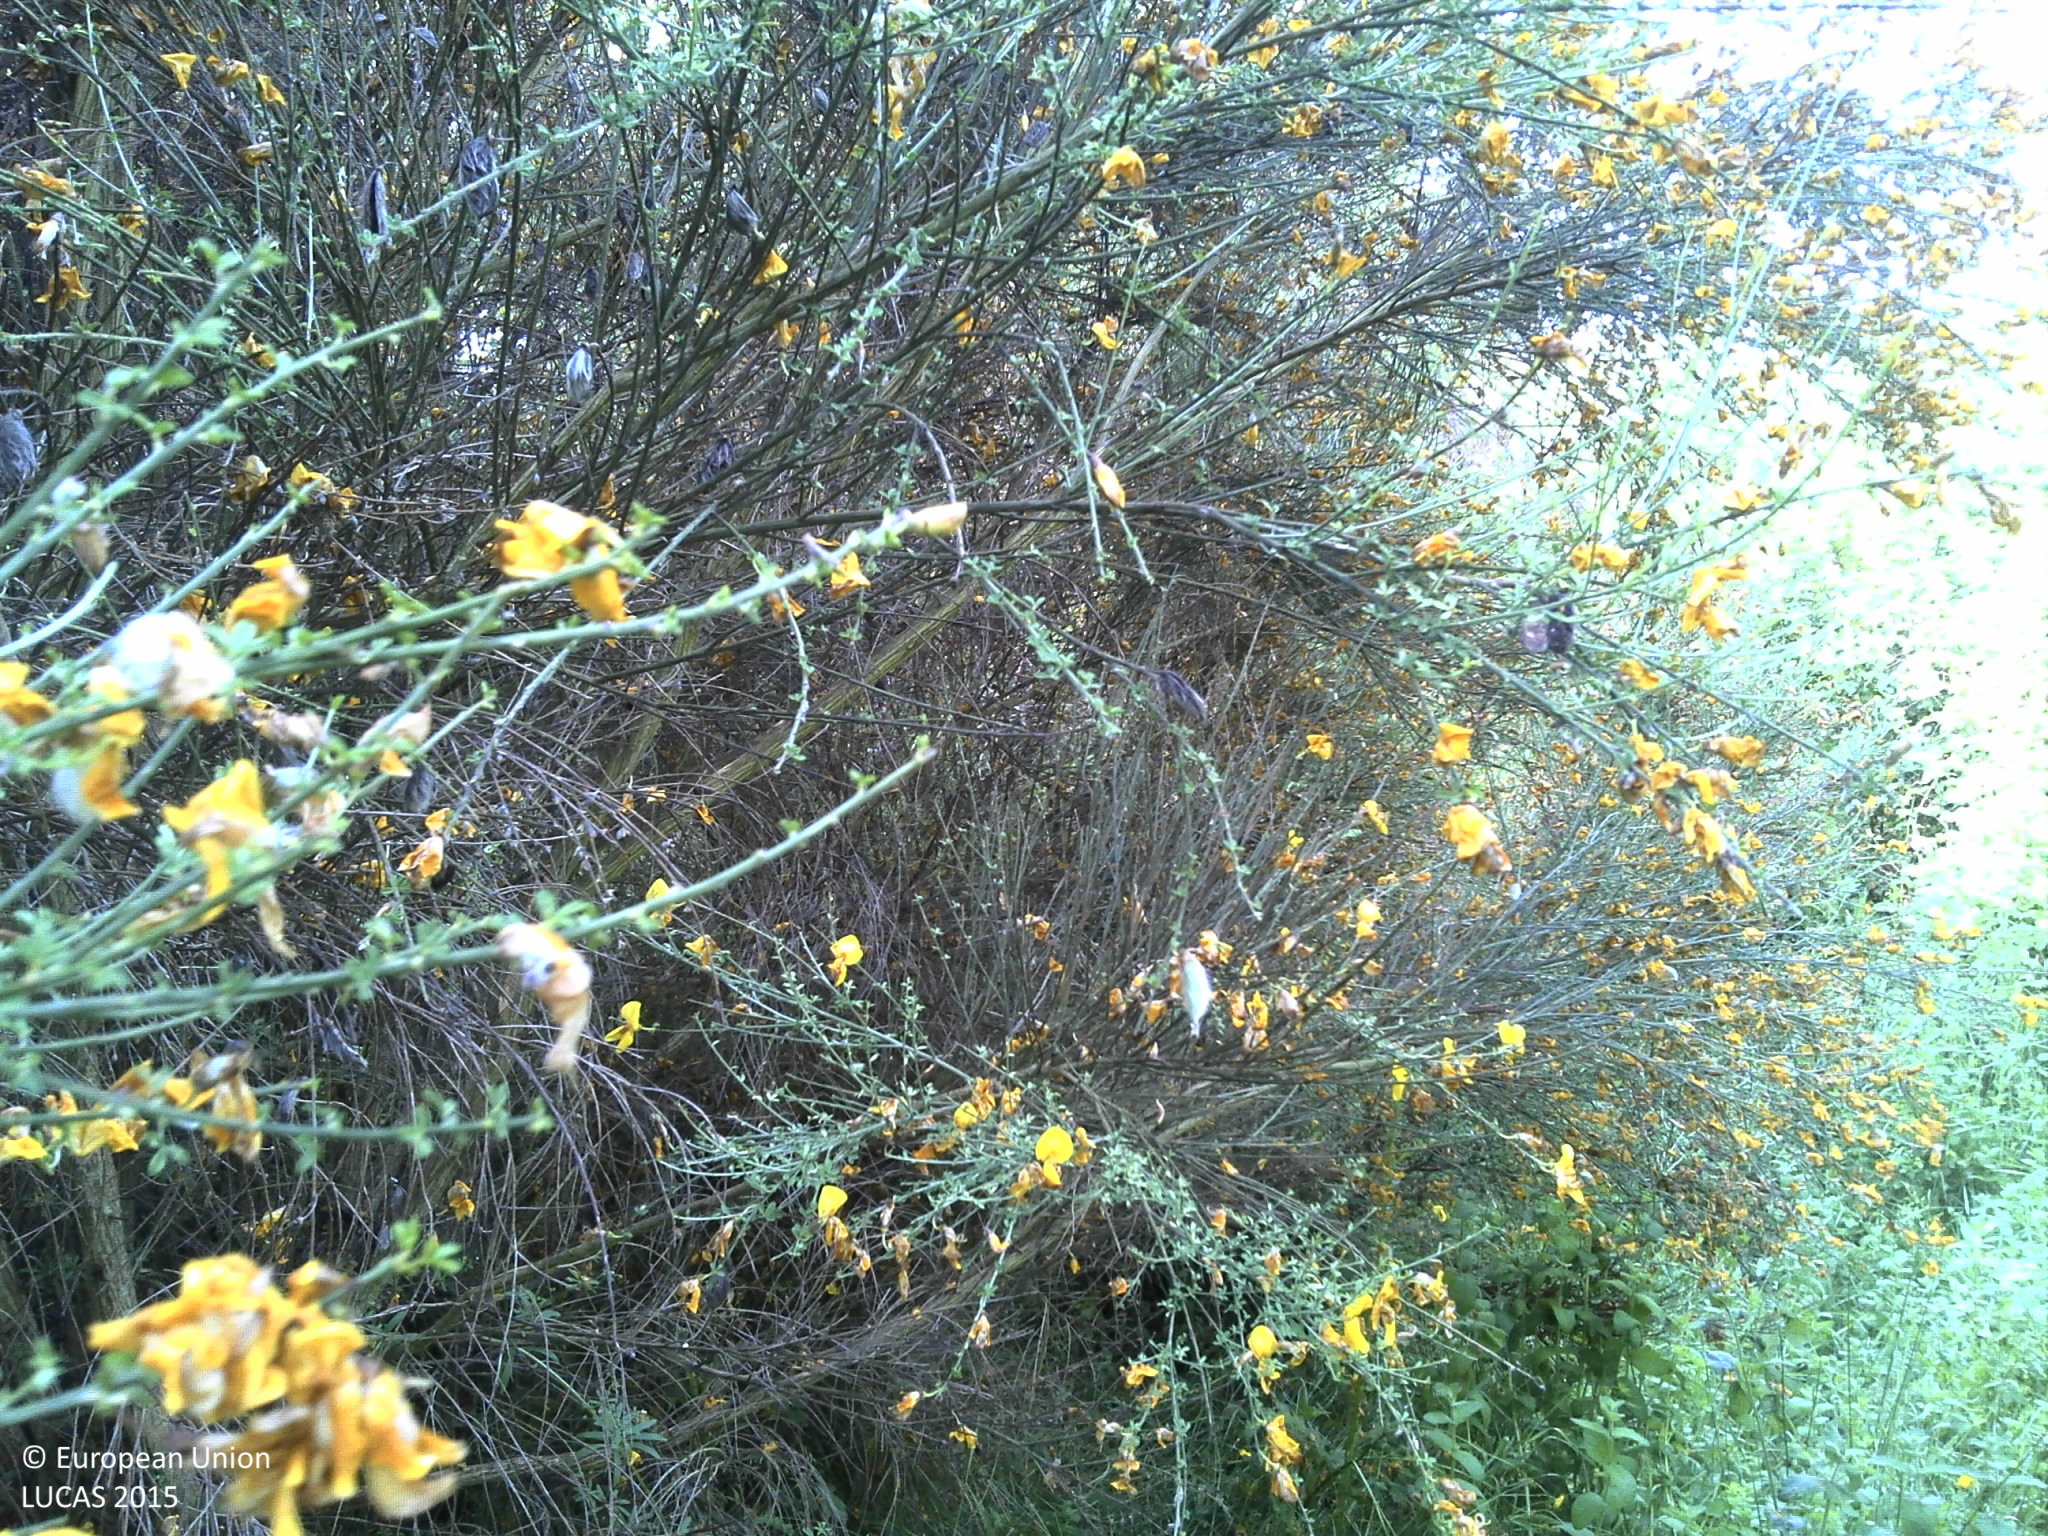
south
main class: Shrubland
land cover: Shrubland with sparse tree cover
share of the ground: > 75 %
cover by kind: shrubs 85 %, herbaceous plants 10 %, broadleaved forest trees 5 %
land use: Semi-natural and natural areas not in use
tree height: > 5 m
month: June
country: PT
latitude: 41.4275
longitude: -7.5132
